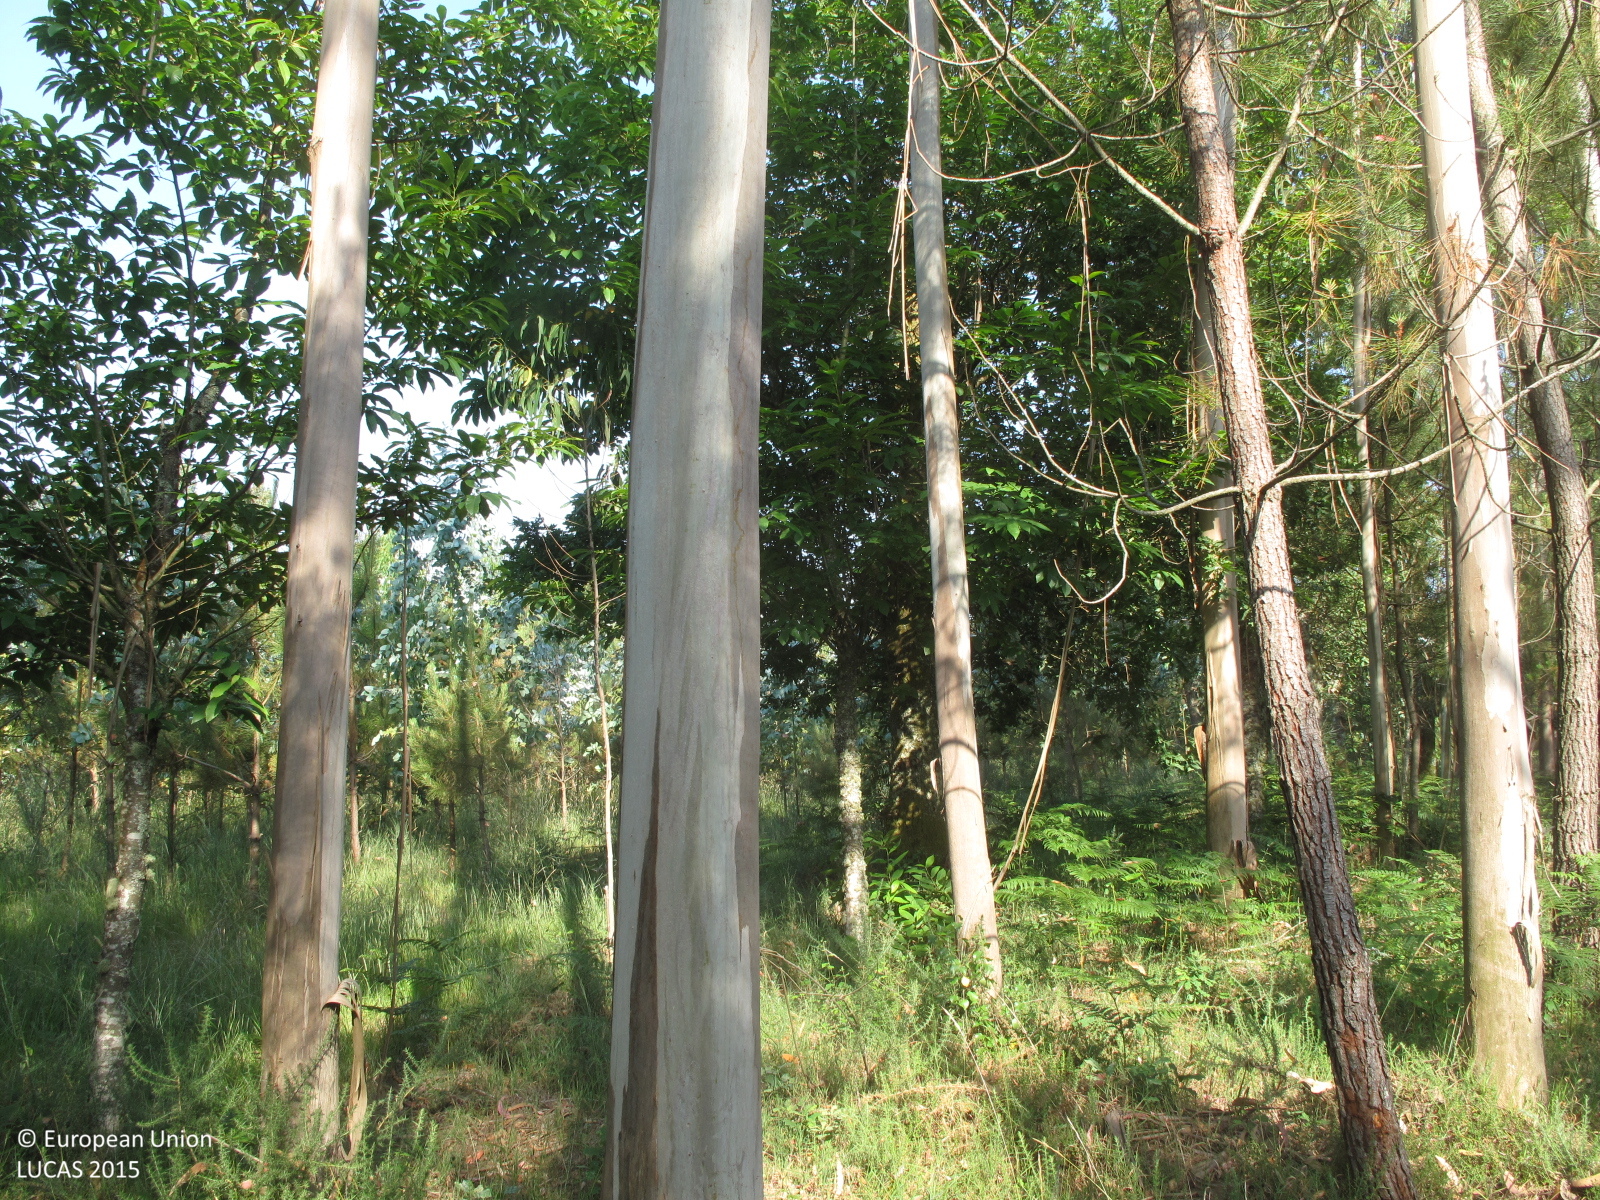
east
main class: Woodland
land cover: Pine dominated coniferous woodland
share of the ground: 50 - 75 %
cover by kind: coniferous forest trees 60 %, herbaceous plants 30 %, broadleaved forest trees 10 %
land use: Forestry
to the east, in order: Pine dominated coniferous woodland; Tracks; Broadleaved woodland; Tracks; Broadleaved woodland; Fences; Grassland with sparse tree/shrub cover; Broadleaved woodland; Tracks; Broadleaved woodland; Fences; Broadleaved woodland; Pine dominated coniferous woodland; Broadleaved woodland; Fences; Grassland without tree/shrub cover
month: June
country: ES
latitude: 43.2164
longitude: -8.0291
